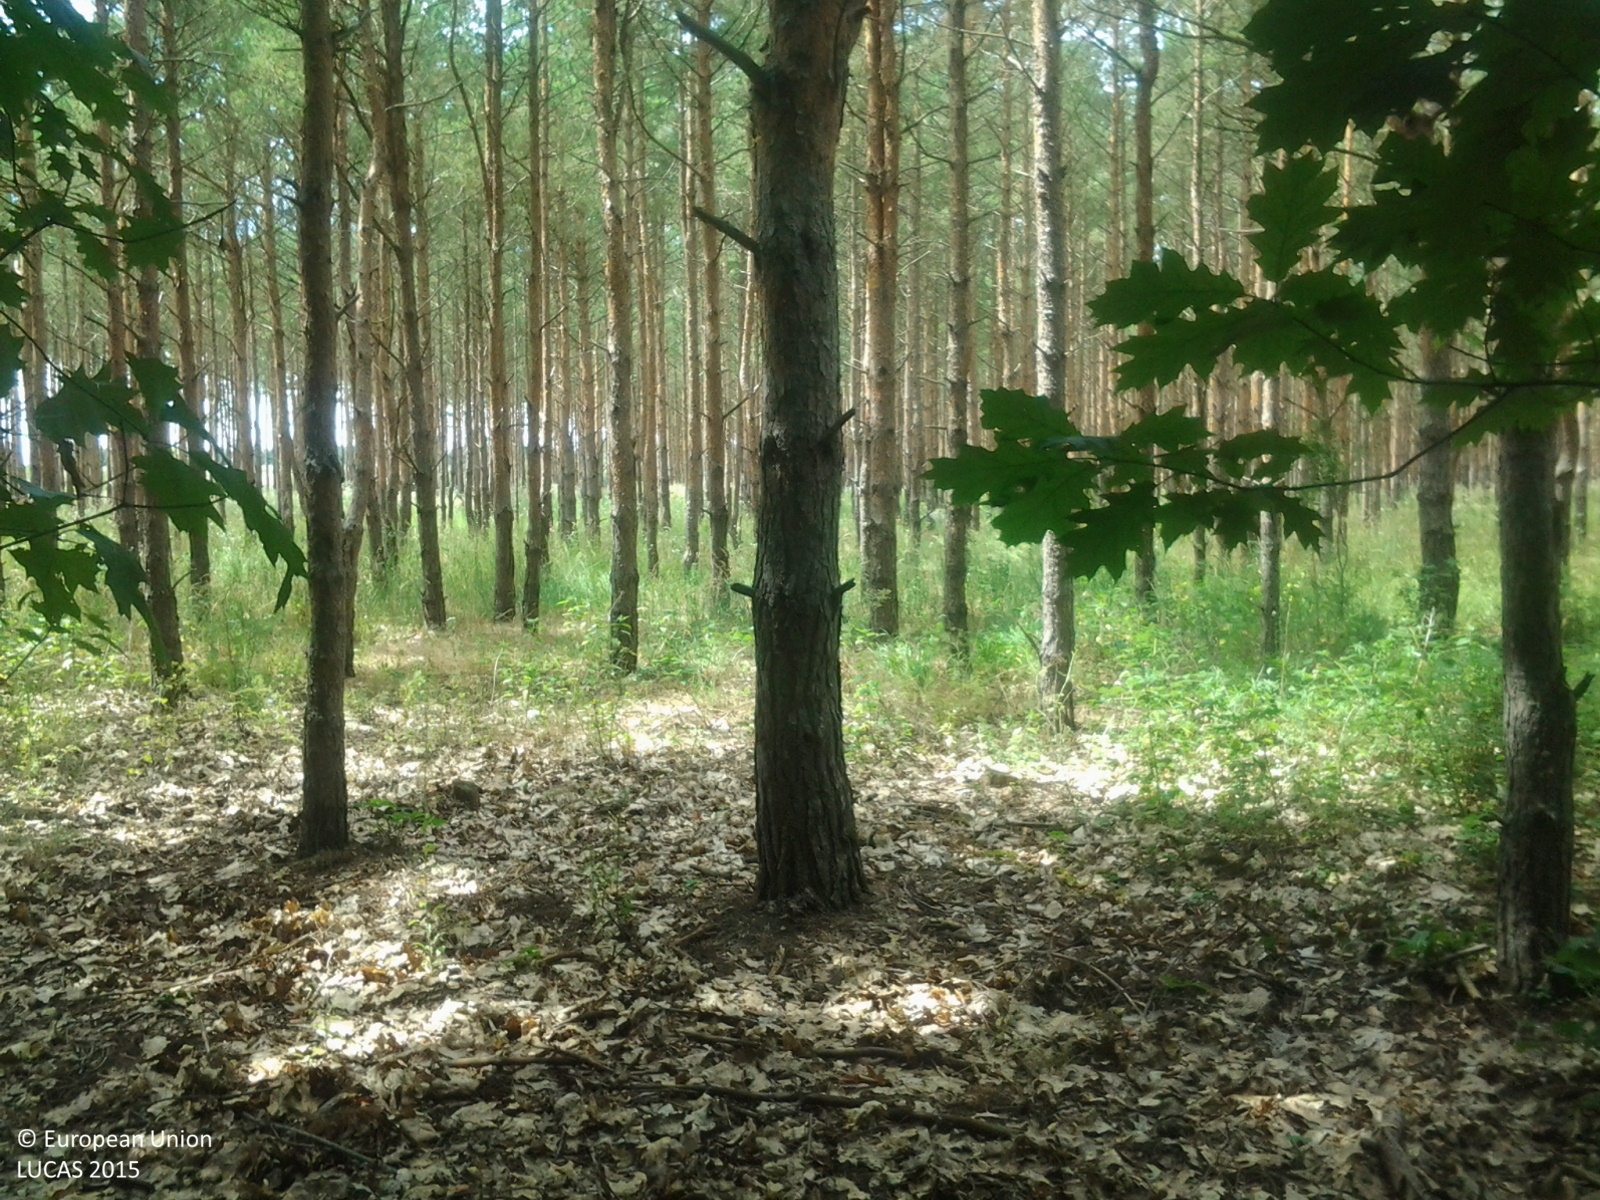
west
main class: Woodland
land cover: Broadleaved woodland
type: acidophilous oak and oak-birch forest
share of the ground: > 75 %
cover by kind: broadleaved forest trees 95 %, unconsolidated bare surface 5 %
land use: Forestry
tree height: > 5 m
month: June
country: HU
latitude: 46.8672
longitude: 17.2070
